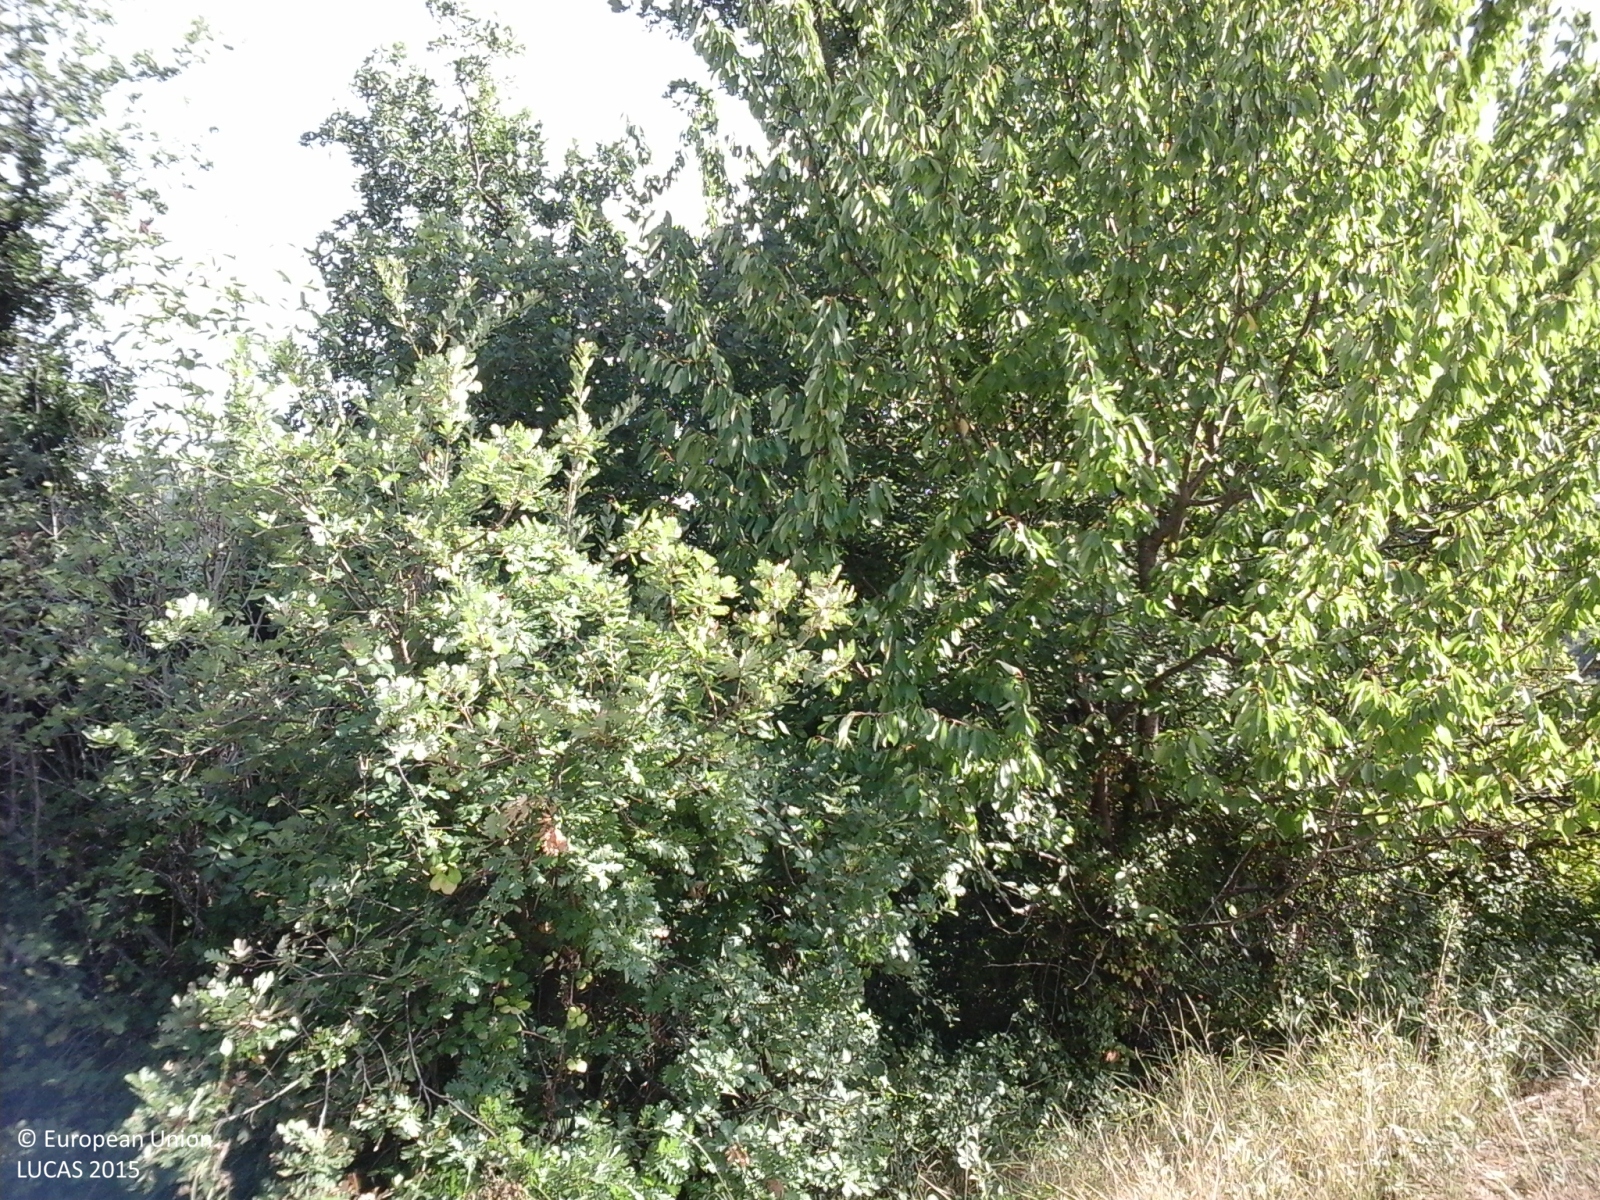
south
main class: Cropland
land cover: Common wheat
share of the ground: > 75 %
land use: Agriculture (excluding fallow land and kitchen gardens)
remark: Harvested field
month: August
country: IT
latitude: 43.0130
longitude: 13.3892
